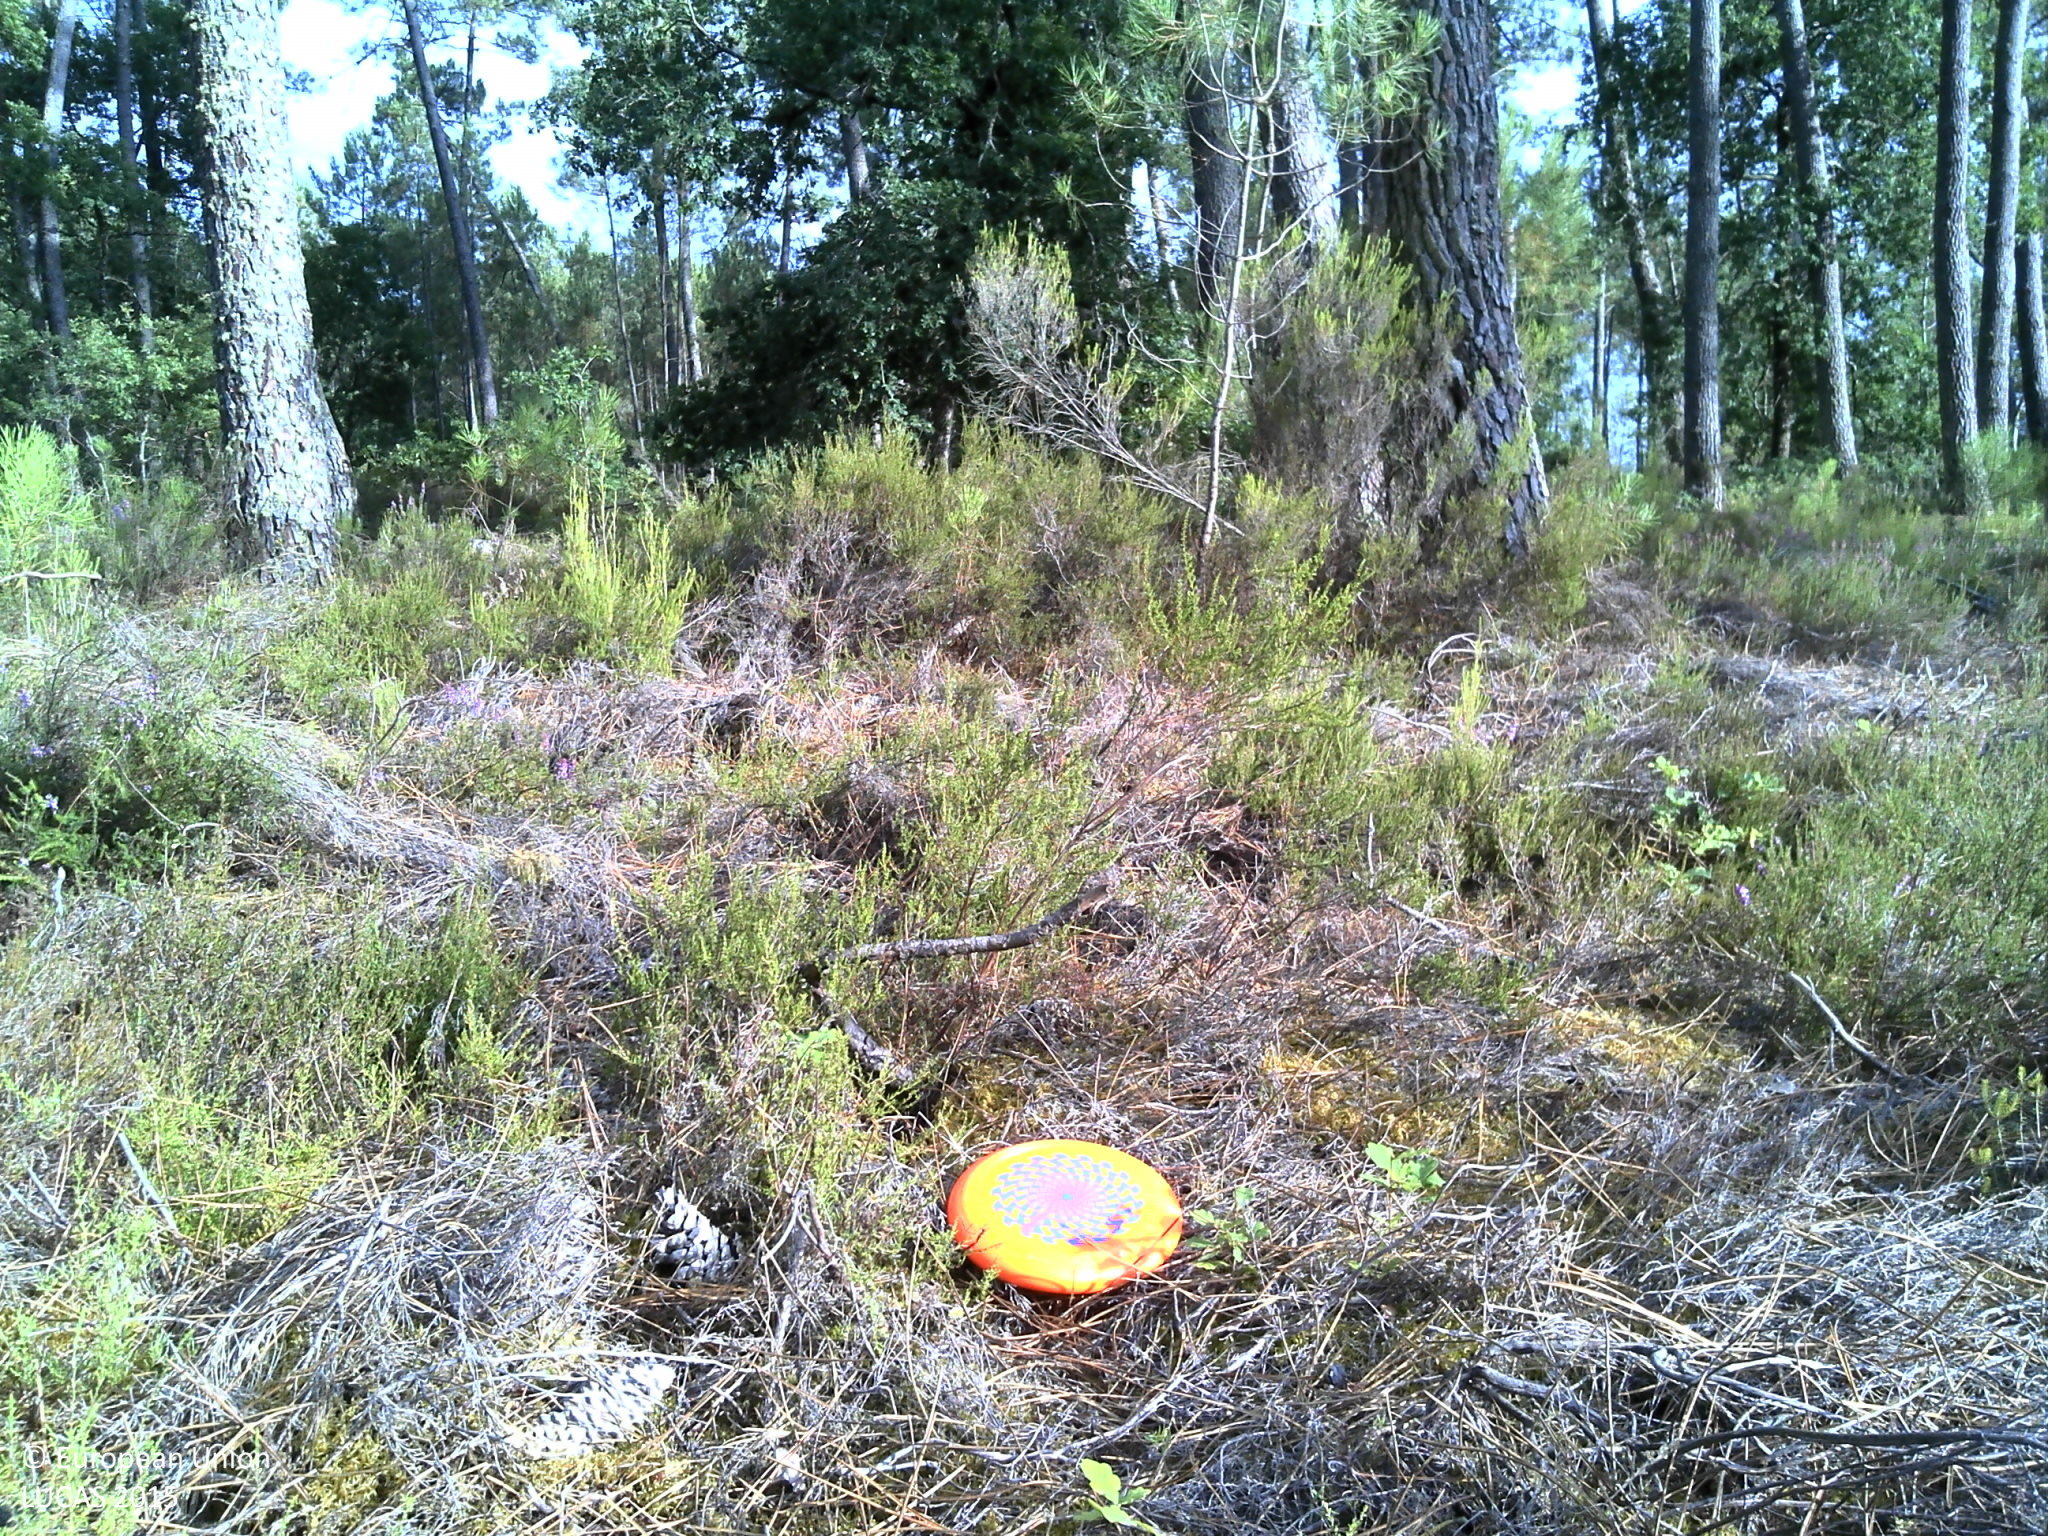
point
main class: Woodland
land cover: Pine dominated coniferous woodland
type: coniferous forest of the mediterranean region
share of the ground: 50 - 75 %
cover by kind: coniferous forest trees 60 %, shrubs 30 %, herbaceous plants 5 %, lichens and mosses 5 %
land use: Forestry
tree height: > 5 m
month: July
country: FR
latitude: 44.5021
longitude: -0.8990
